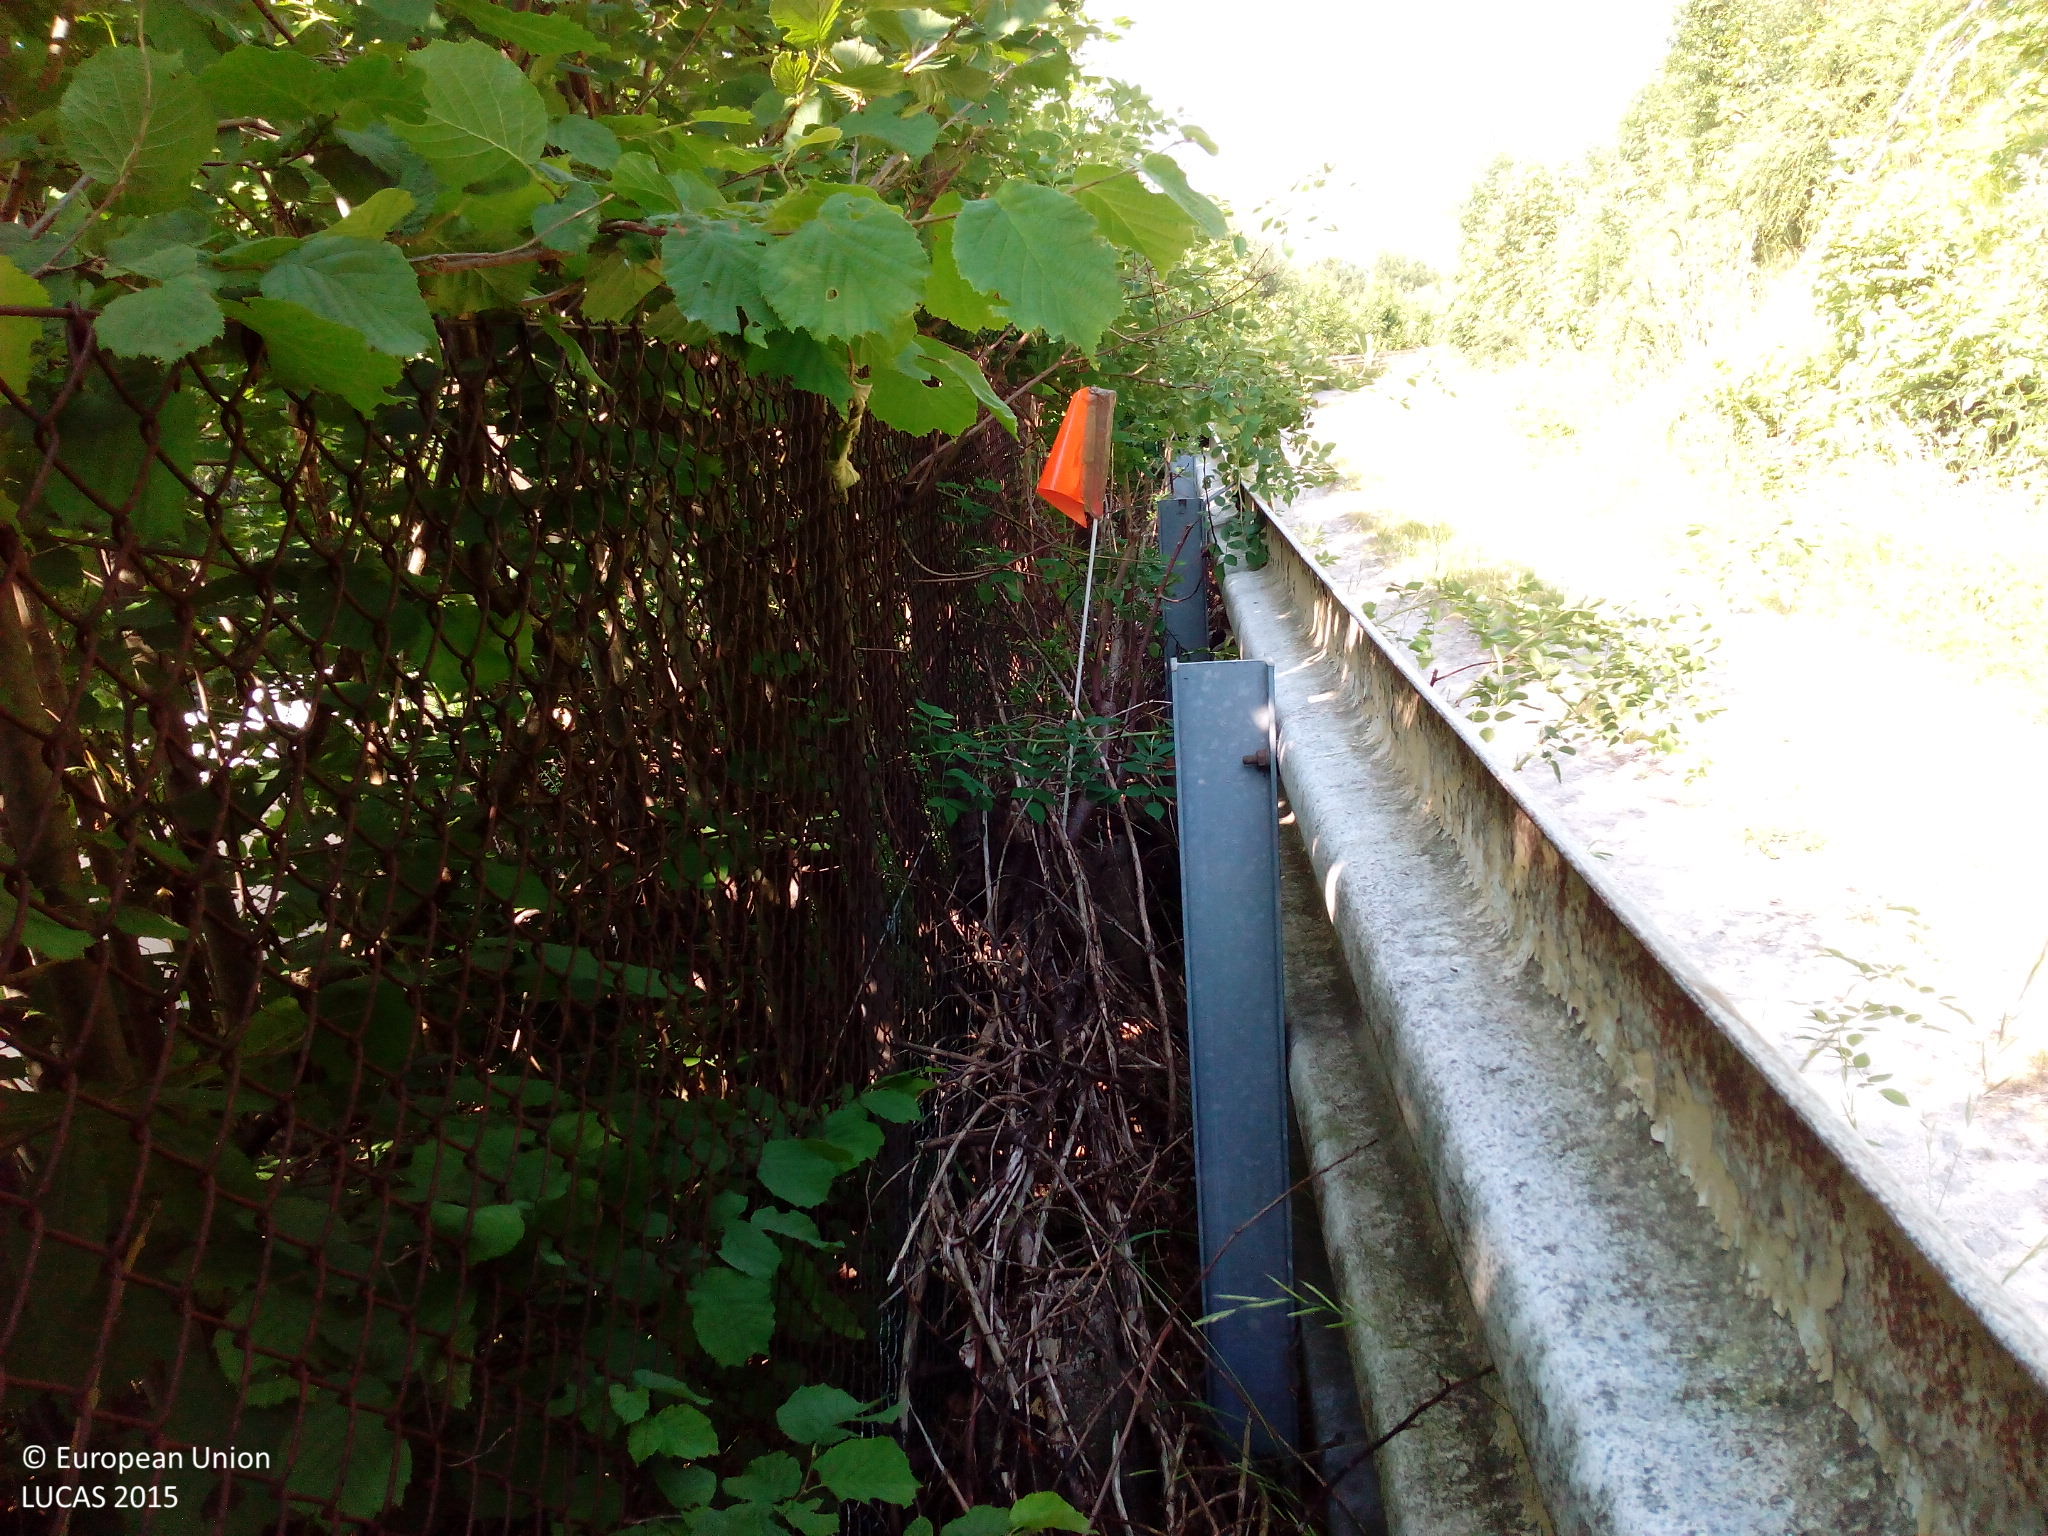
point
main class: Woodland
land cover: Broadleaved woodland
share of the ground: > 75 %
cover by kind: broadleaved forest trees 75 %, shrubs 25 %
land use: Road transport
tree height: < 5 m
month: July
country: DE
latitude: 48.5648
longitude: 9.6343
